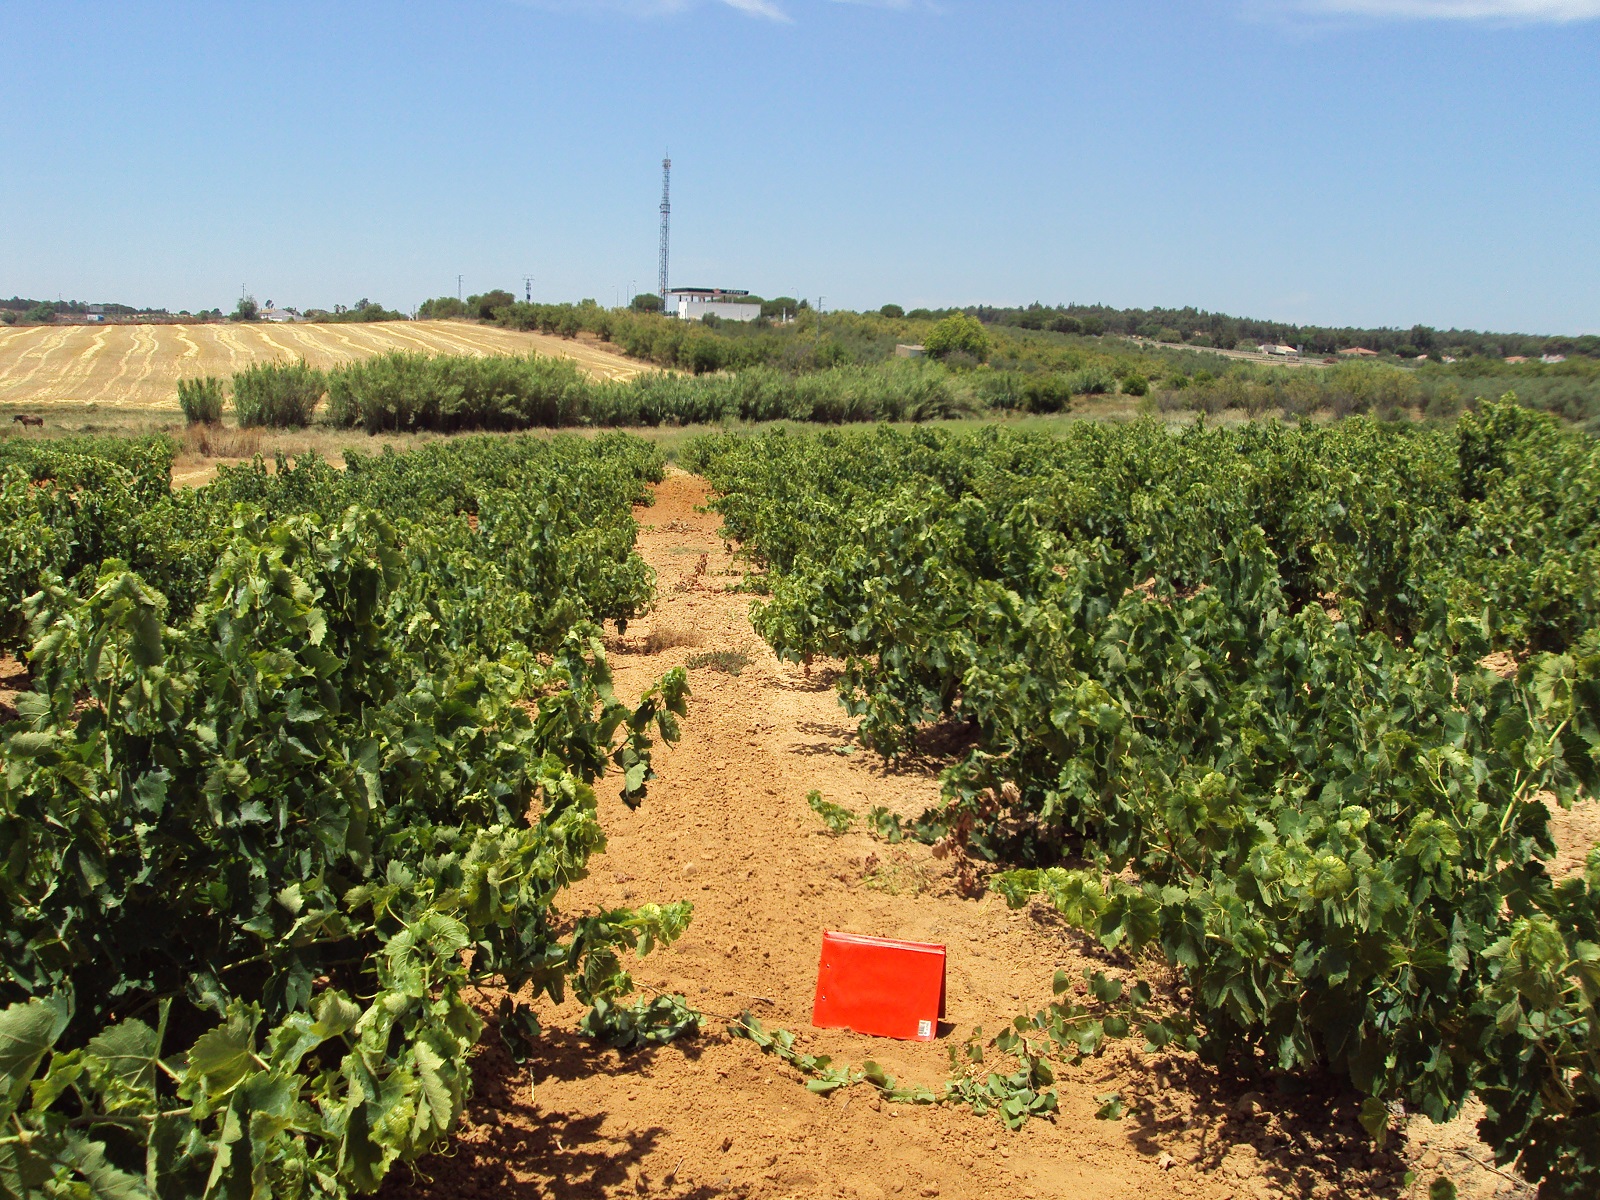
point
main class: Cropland
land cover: Vineyards
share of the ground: > 75 %
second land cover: Other bare soil
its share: > 75 %
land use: Agriculture (excluding fallow land and kitchen gardens)
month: June
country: ES
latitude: 37.3493
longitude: -6.5942
